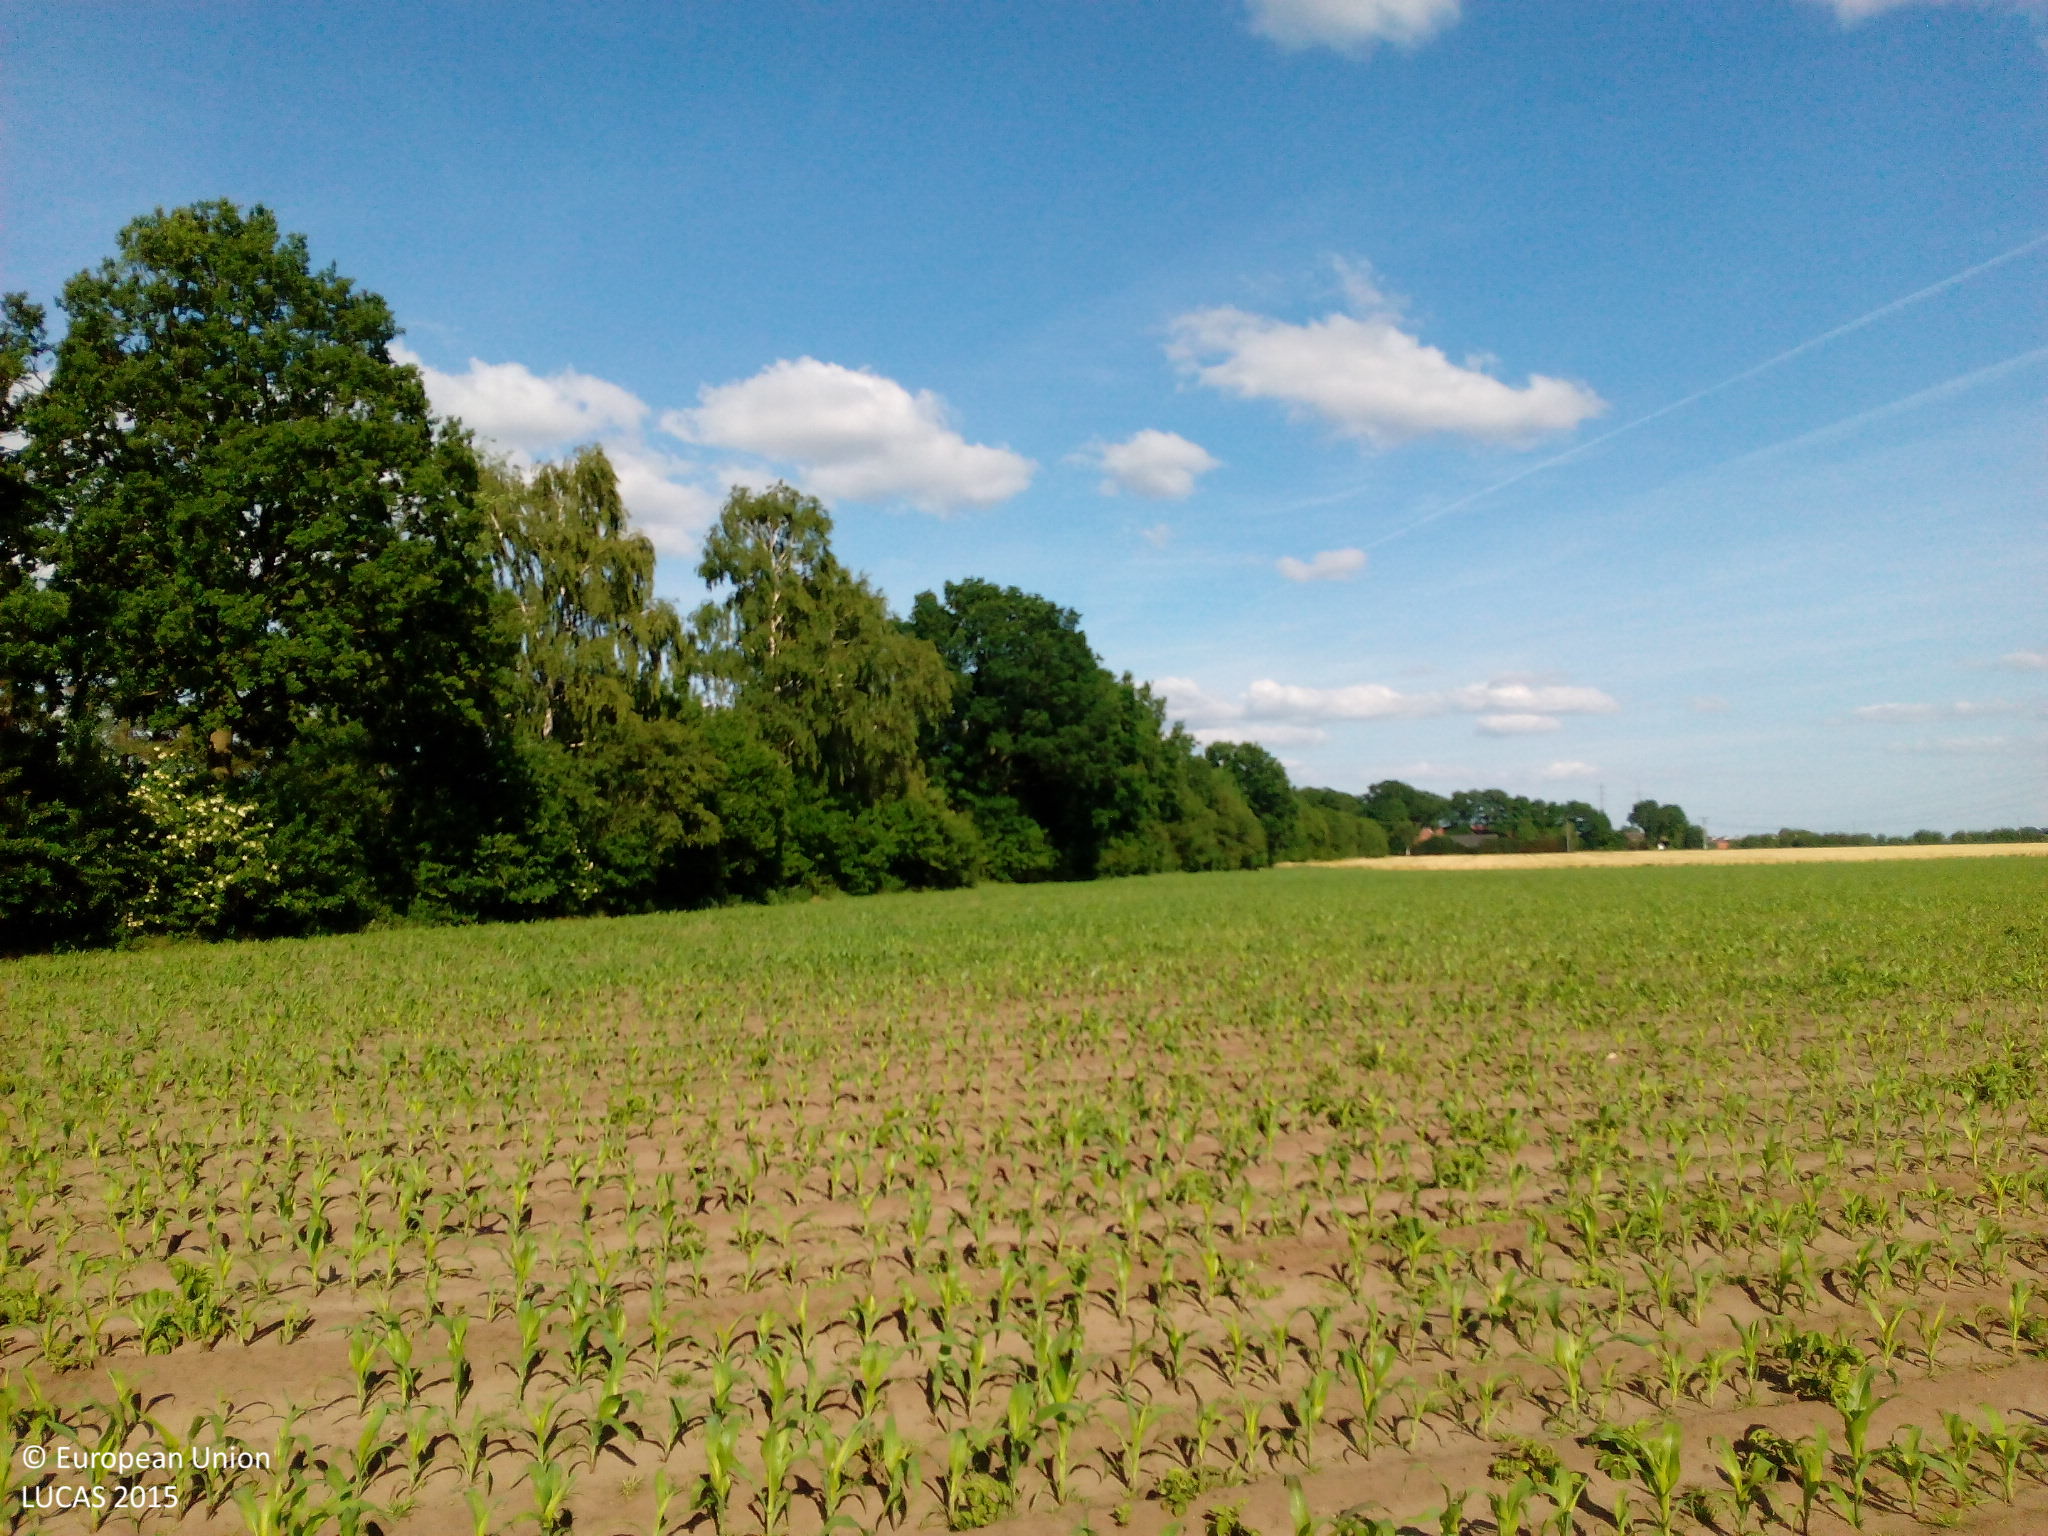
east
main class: Cropland
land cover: Maize
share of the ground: 10 - 25 %
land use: Agriculture (excluding fallow land and kitchen gardens)
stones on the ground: < 10 %
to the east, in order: Maize; Abandoned hedges; Ditches and canals; Grass margins; Paved roads, cycling and walking lanes; Grass margins; Paved roads, cycling and walking lanes; Grass margins; Ditches and canals; Abandoned hedges; Barley
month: June
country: DE
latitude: 52.4754
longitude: 7.4239
